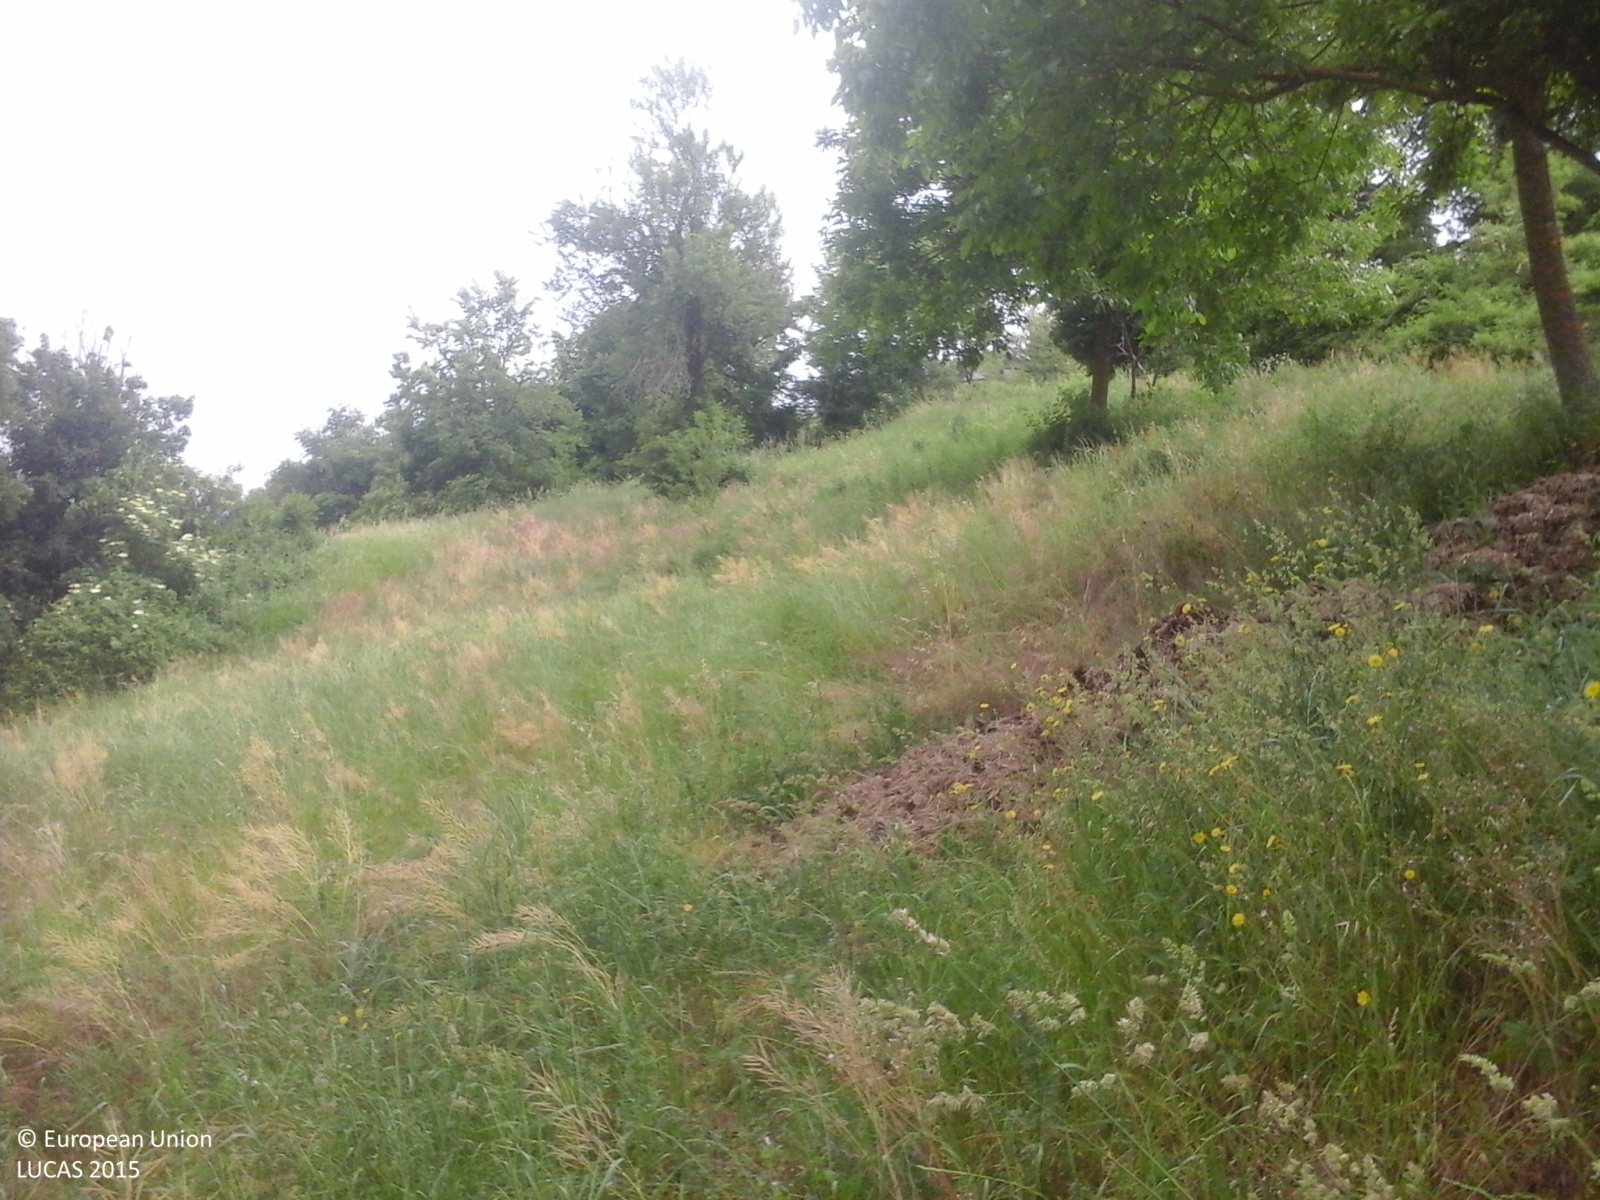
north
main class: Cropland
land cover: Lucerne
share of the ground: > 75 %
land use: Agriculture (excluding fallow land and kitchen gardens)
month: May
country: IT
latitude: 44.2744
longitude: 10.9125
